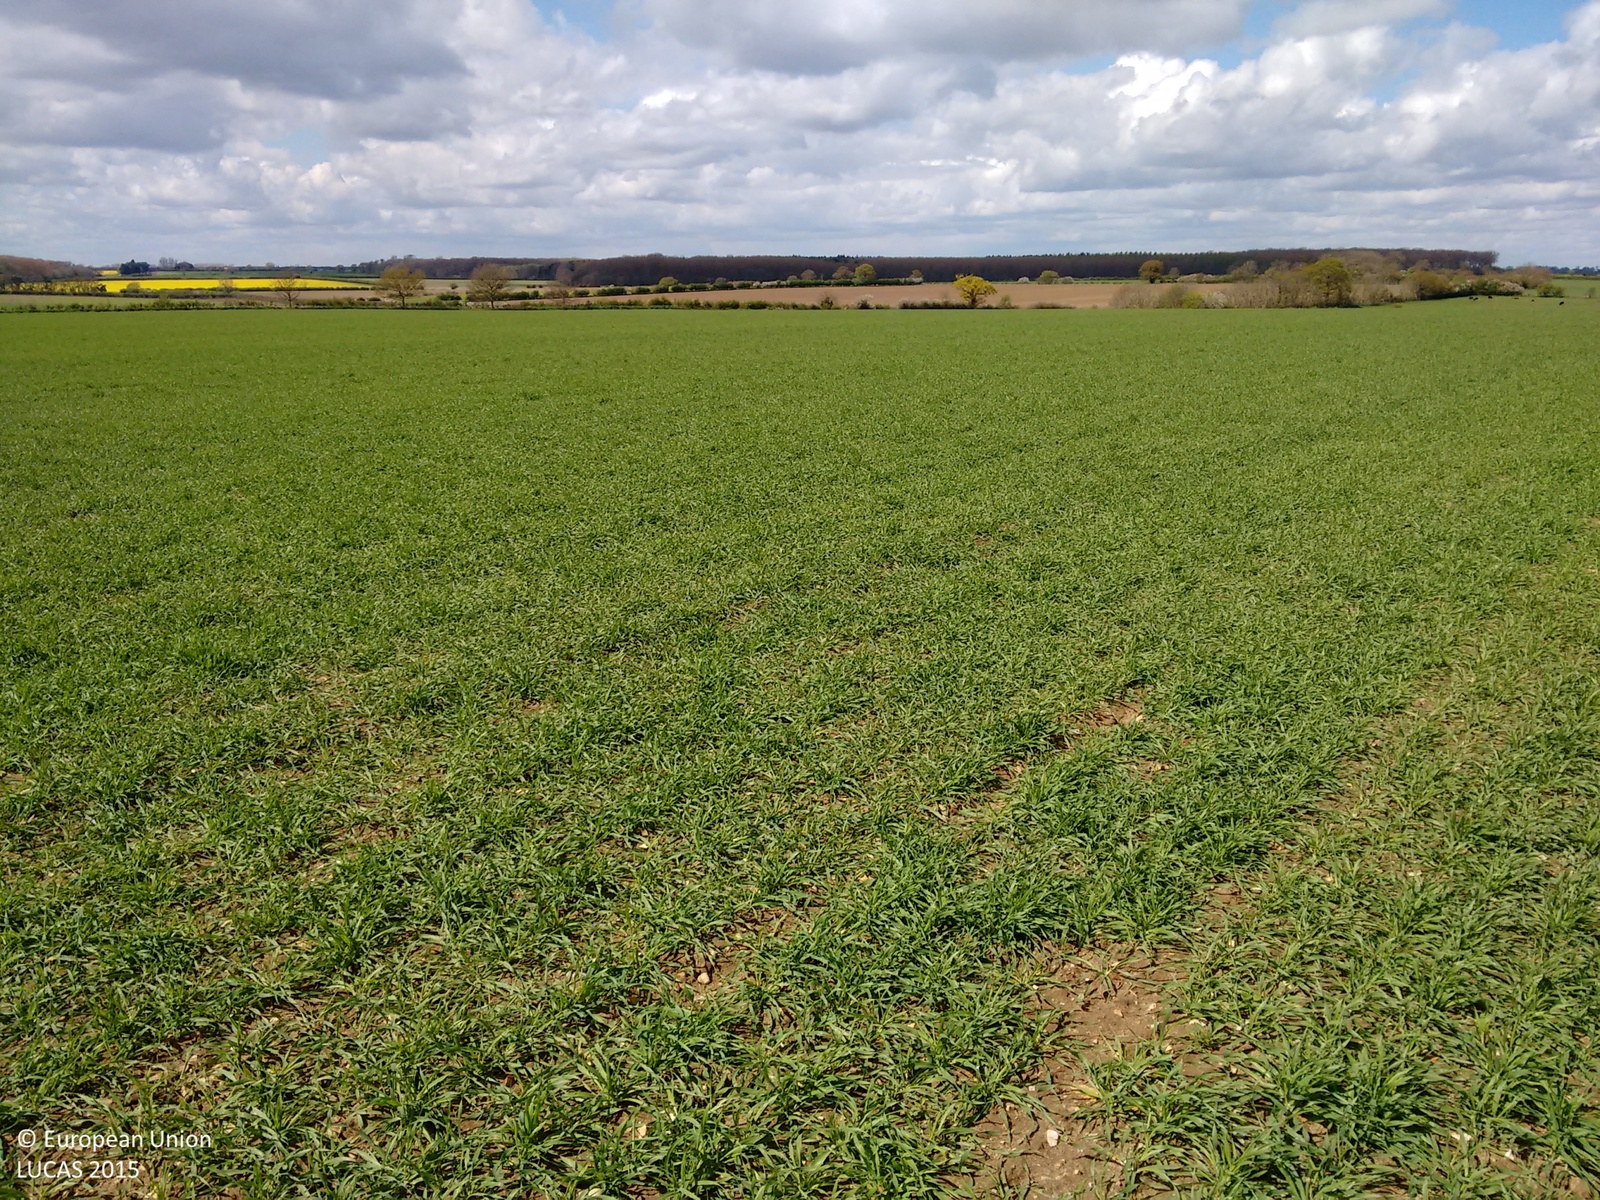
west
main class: Cropland
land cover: Barley
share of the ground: 50 - 75 %
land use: Agriculture (excluding fallow land and kitchen gardens)
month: April
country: GB
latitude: 53.1422
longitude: -0.0943
